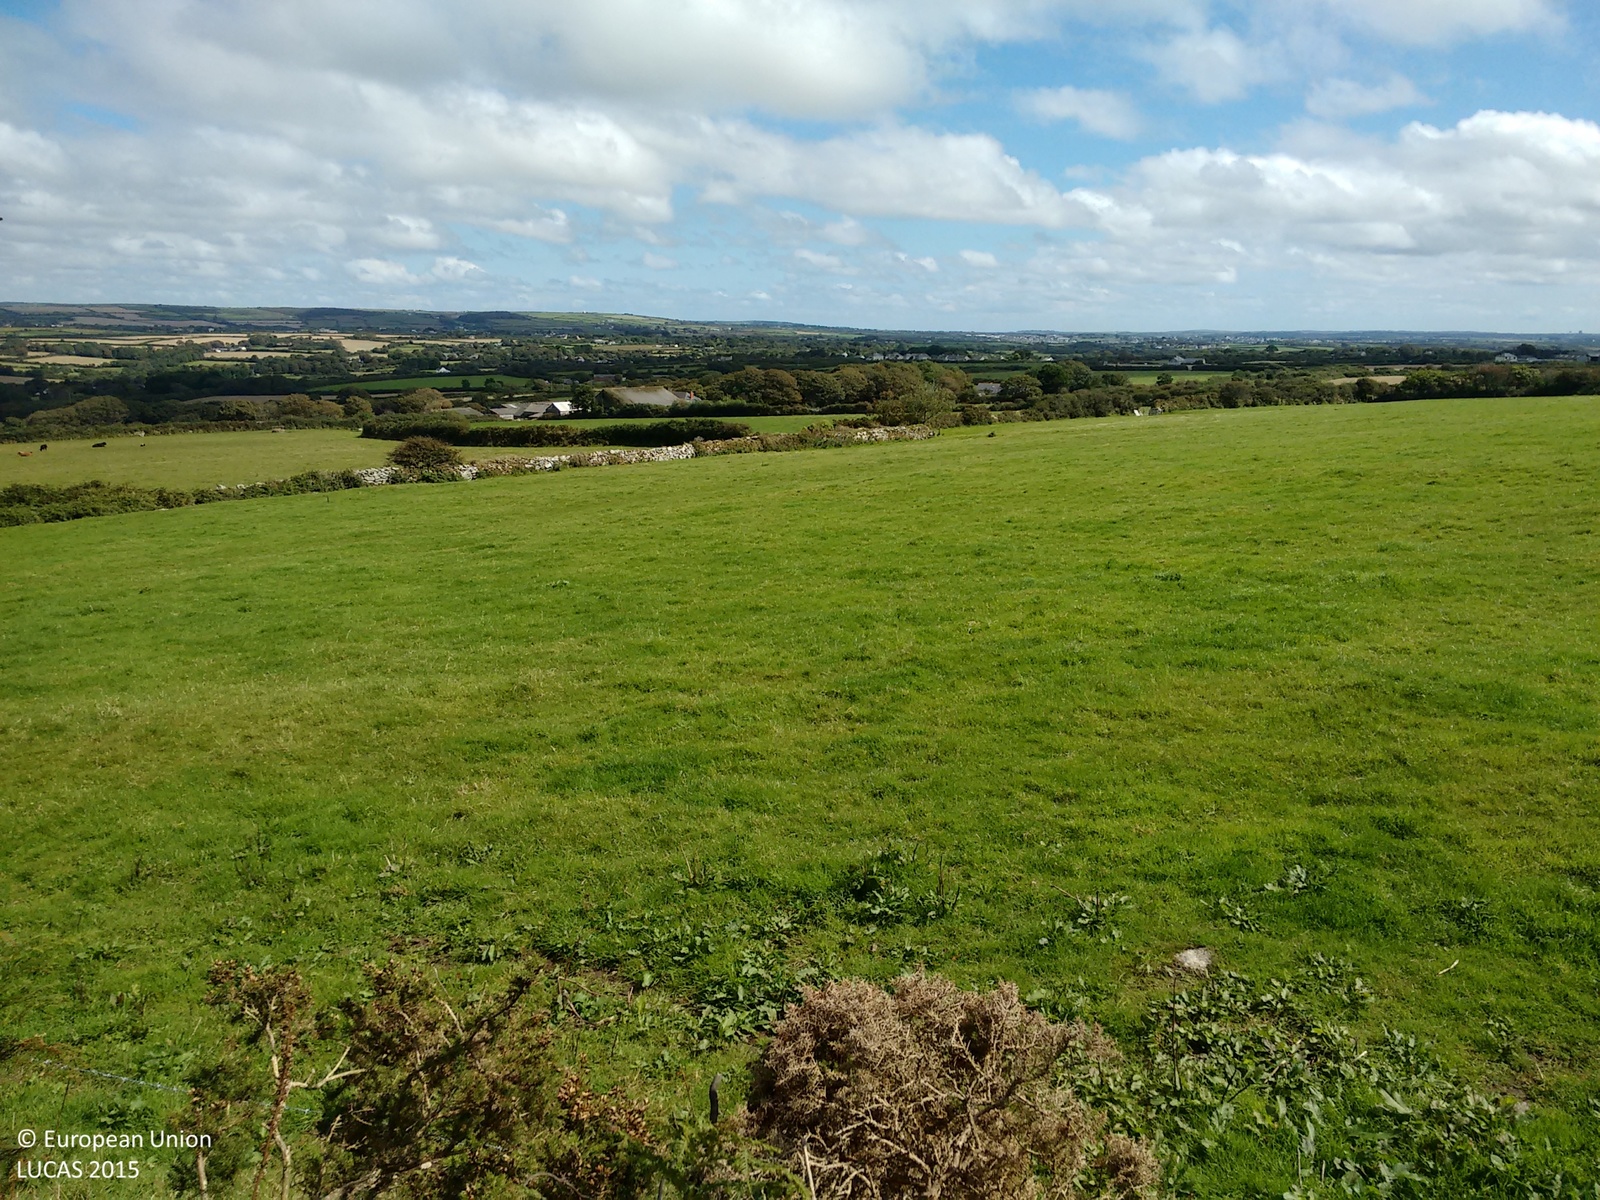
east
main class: Shrubland
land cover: Shrubland without tree cover
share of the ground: > 75 %
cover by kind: shrubs 70 %, herbaceous plants 30 %
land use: Agriculture (excluding fallow land and kitchen gardens)
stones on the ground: < 10 %
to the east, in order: Shrubland without tree cover; Fences; Grassland without tree/shrub cover; Dry stone walls; Fences; Grassland without tree/shrub cover; Managed hedges; Dry stone walls; Grassland without tree/shrub cover
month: September
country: GB
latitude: 50.1244
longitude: -5.3562
